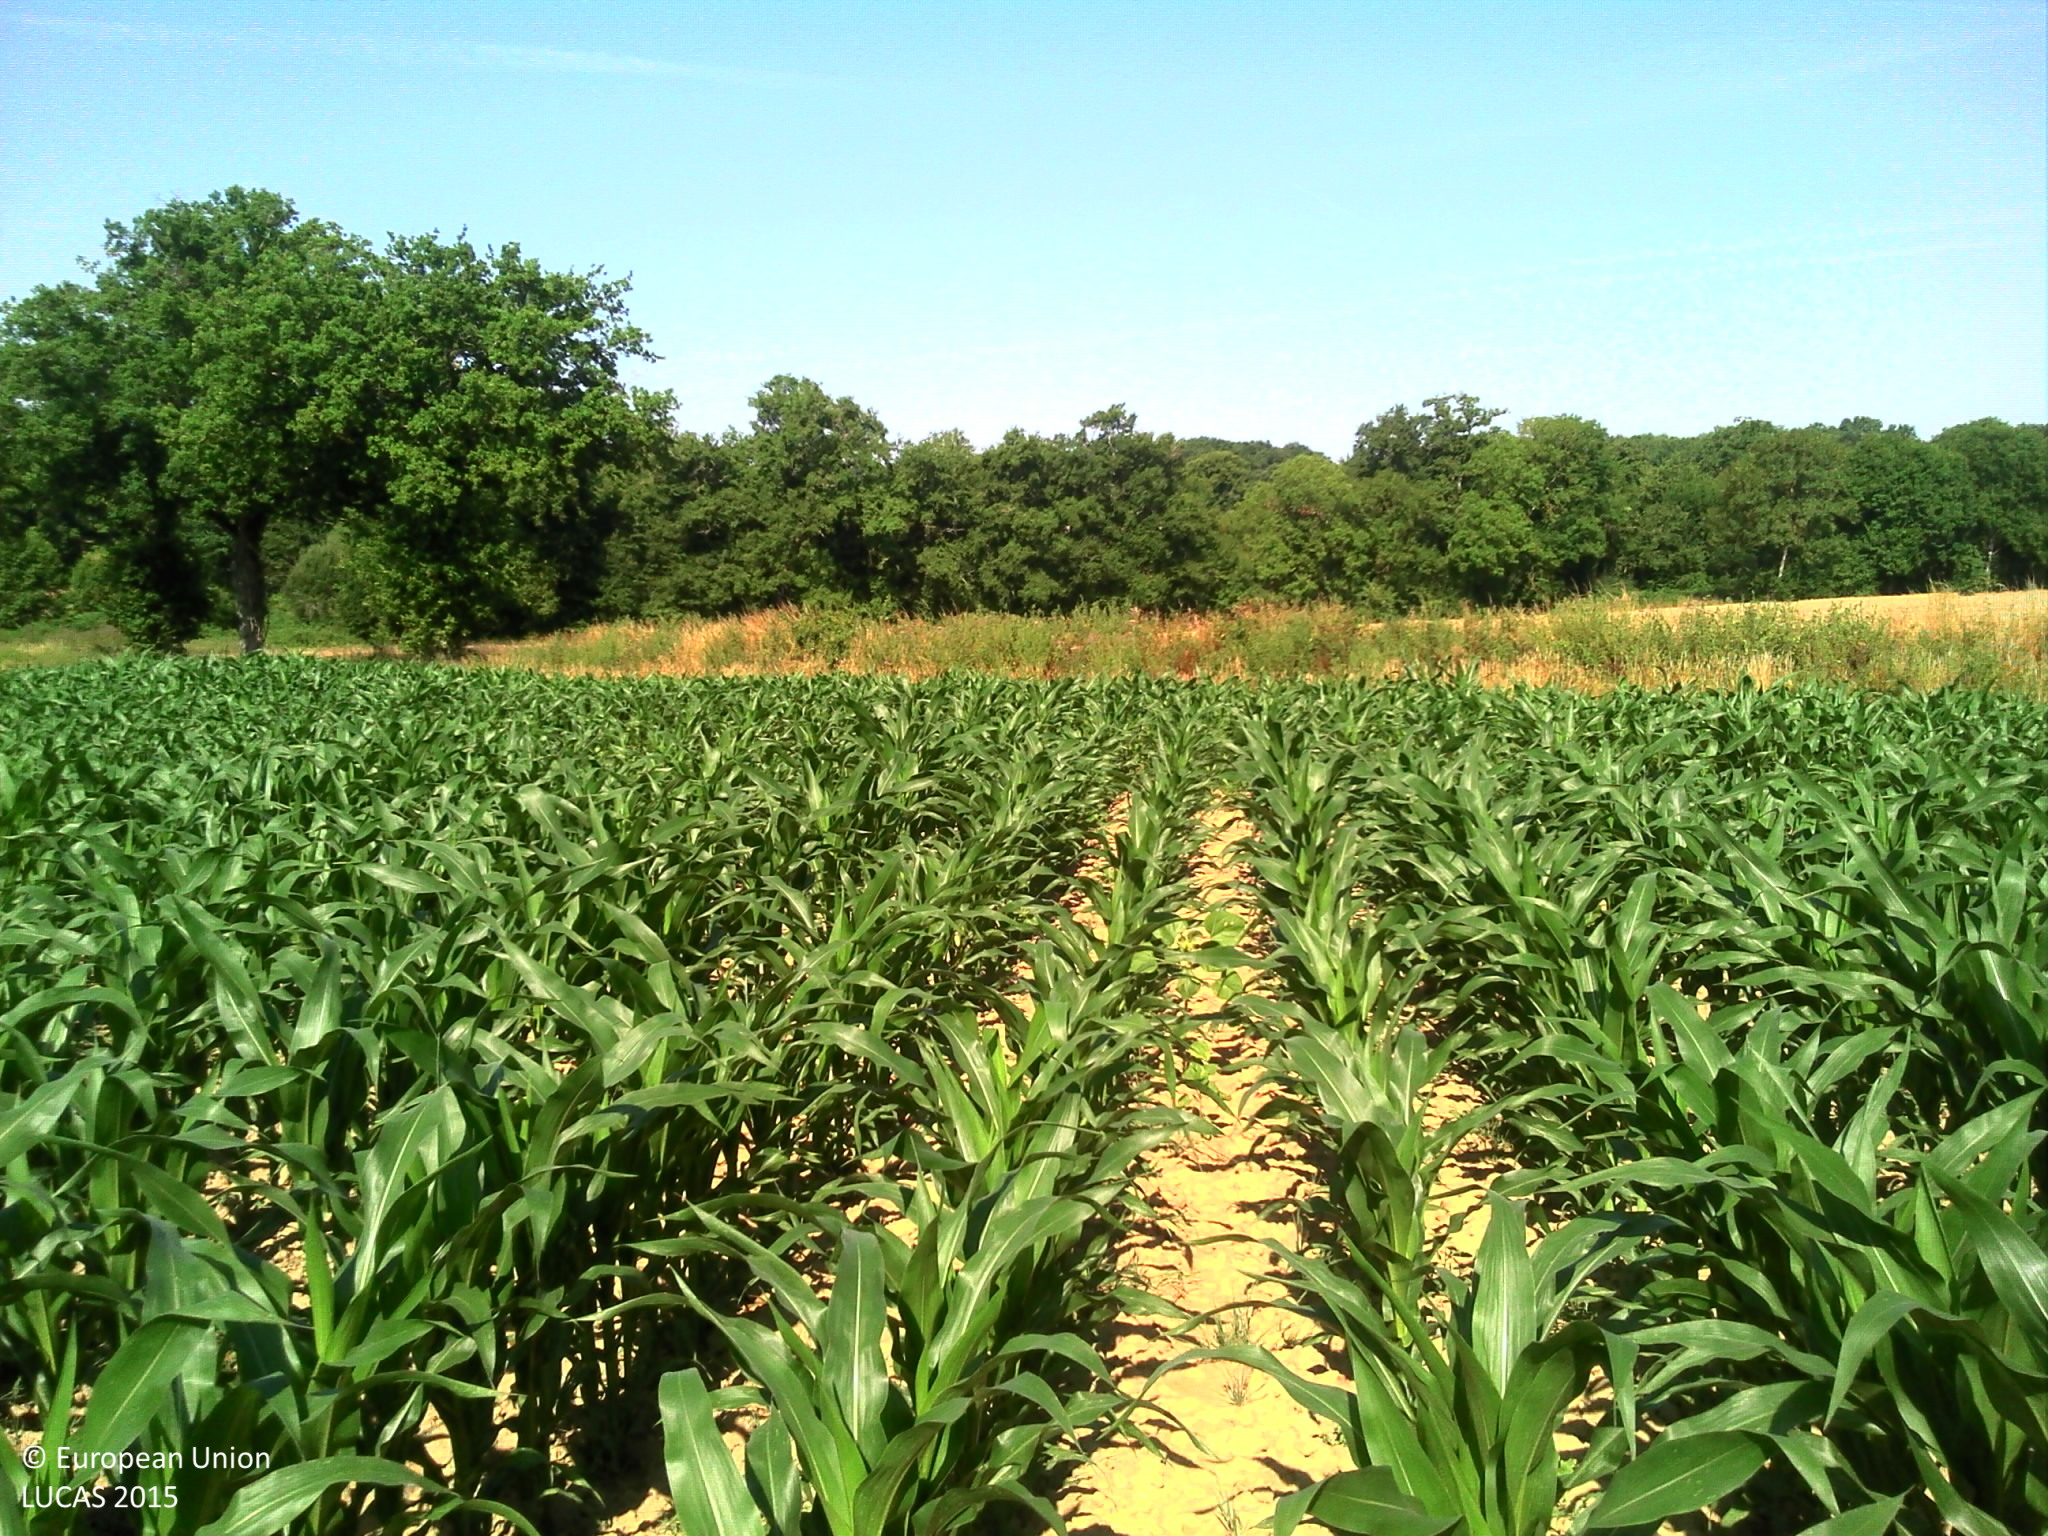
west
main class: Cropland
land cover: Maize
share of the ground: > 75 %
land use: Agriculture (excluding fallow land and kitchen gardens)
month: July
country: FR
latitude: 46.3078
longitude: 0.9103
